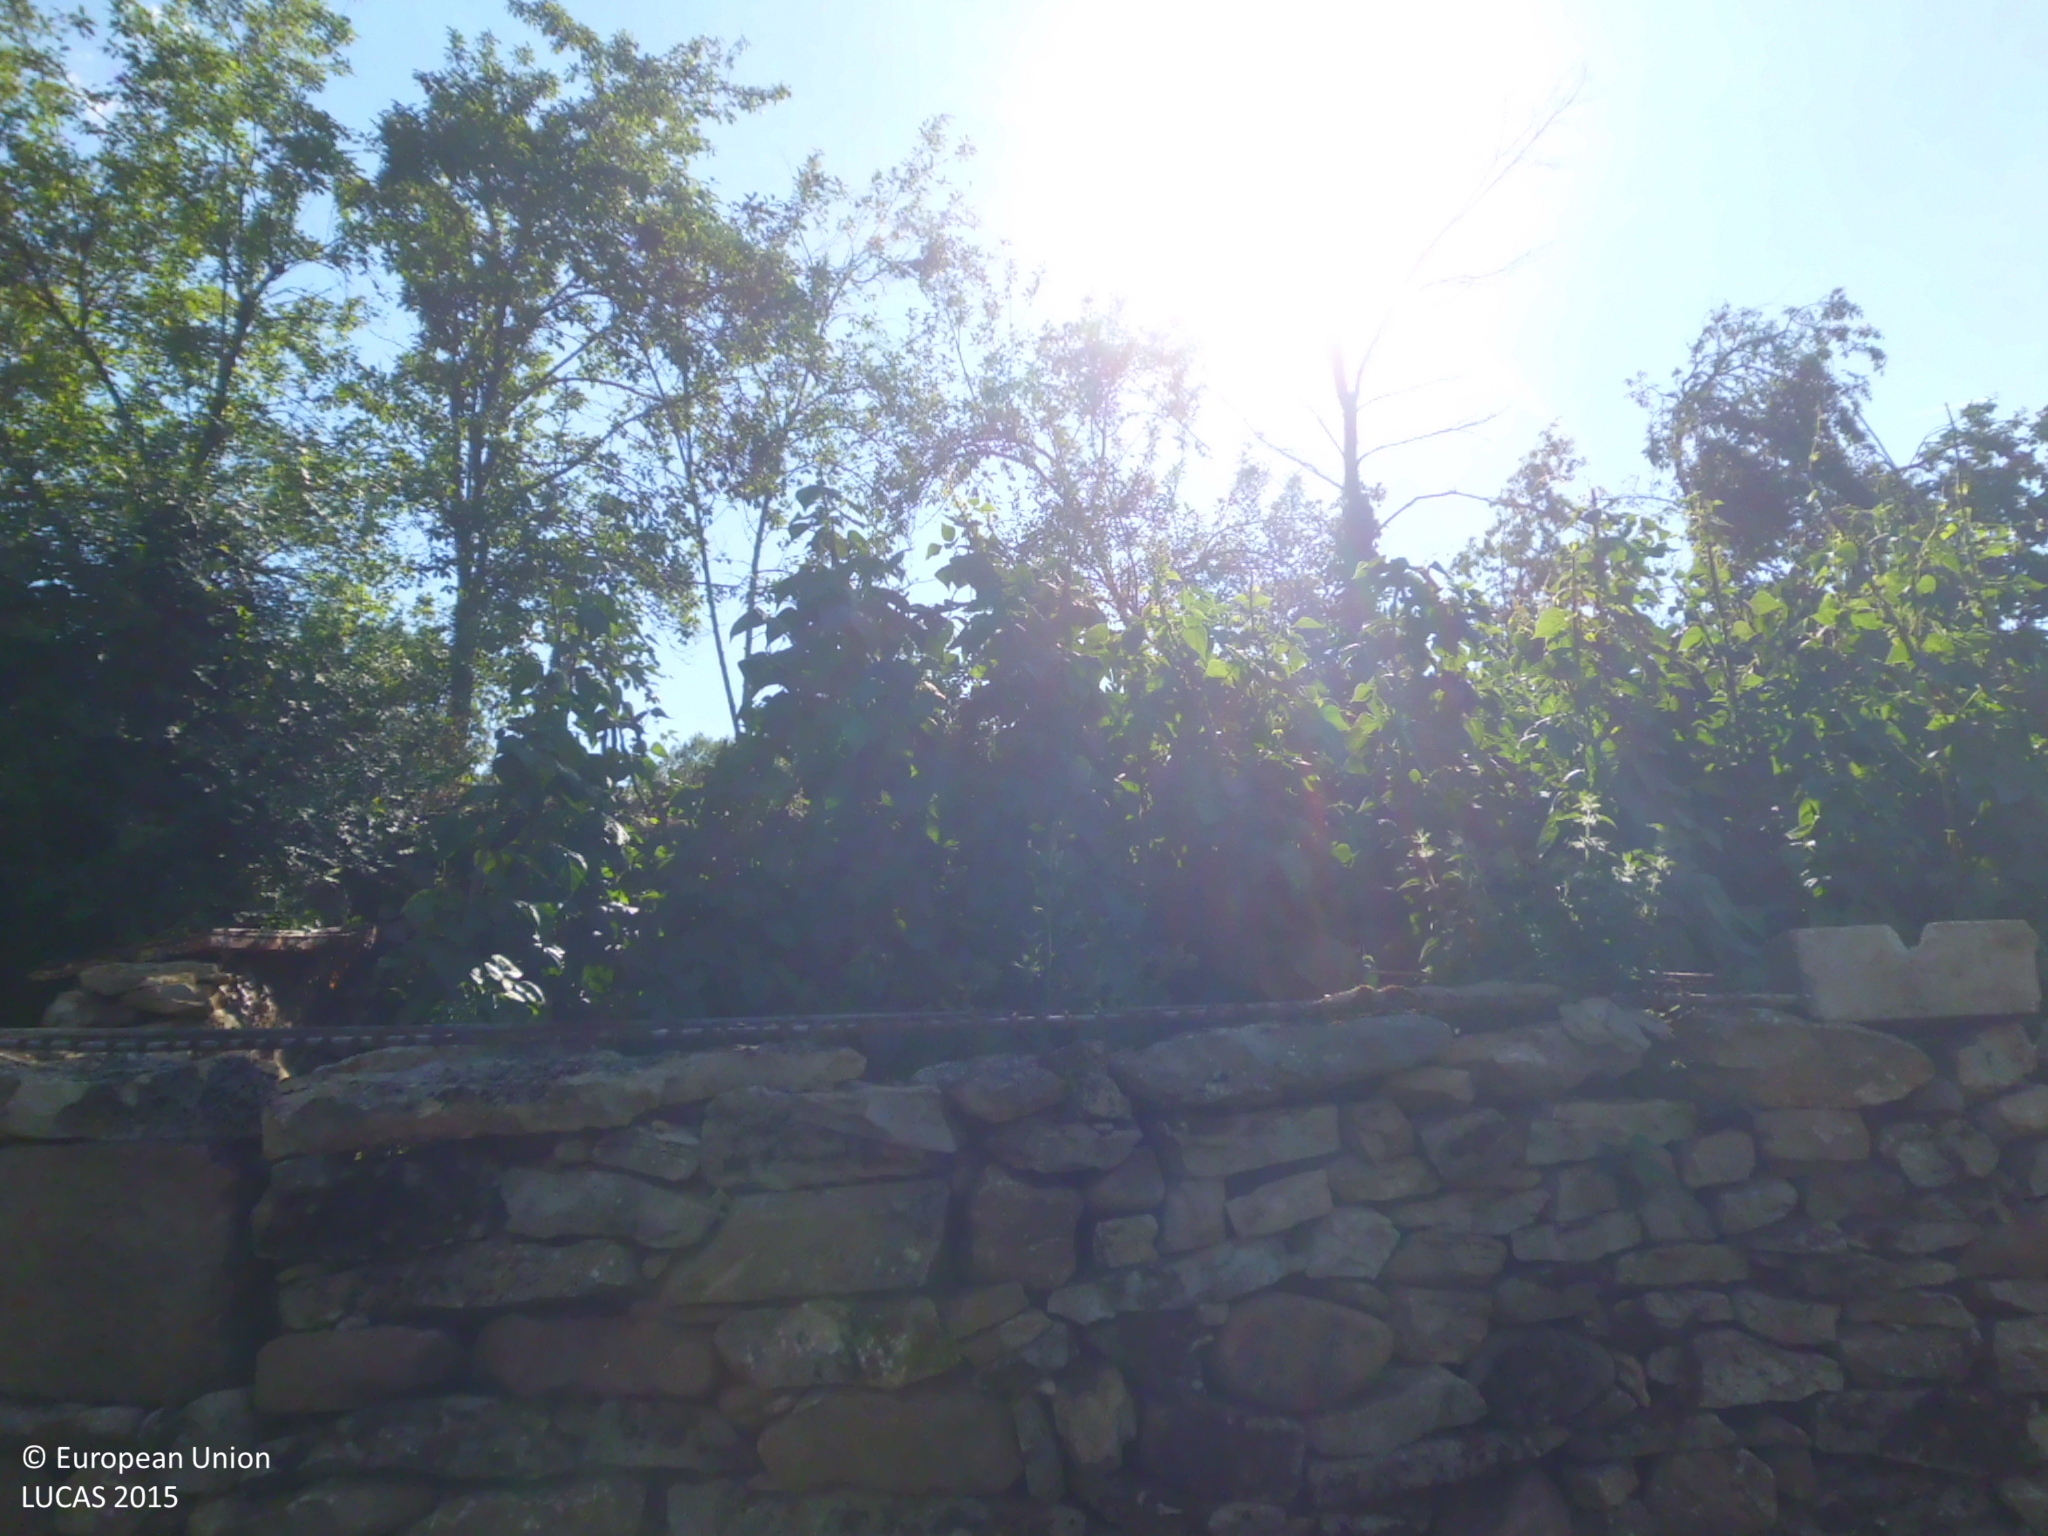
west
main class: Woodland
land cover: Broadleaved woodland
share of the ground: > 75 %
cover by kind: broadleaved forest trees 80 %, shrubs 20 %
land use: Semi-natural and natural areas not in use
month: July
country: ES
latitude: 42.8557
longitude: -4.4585
